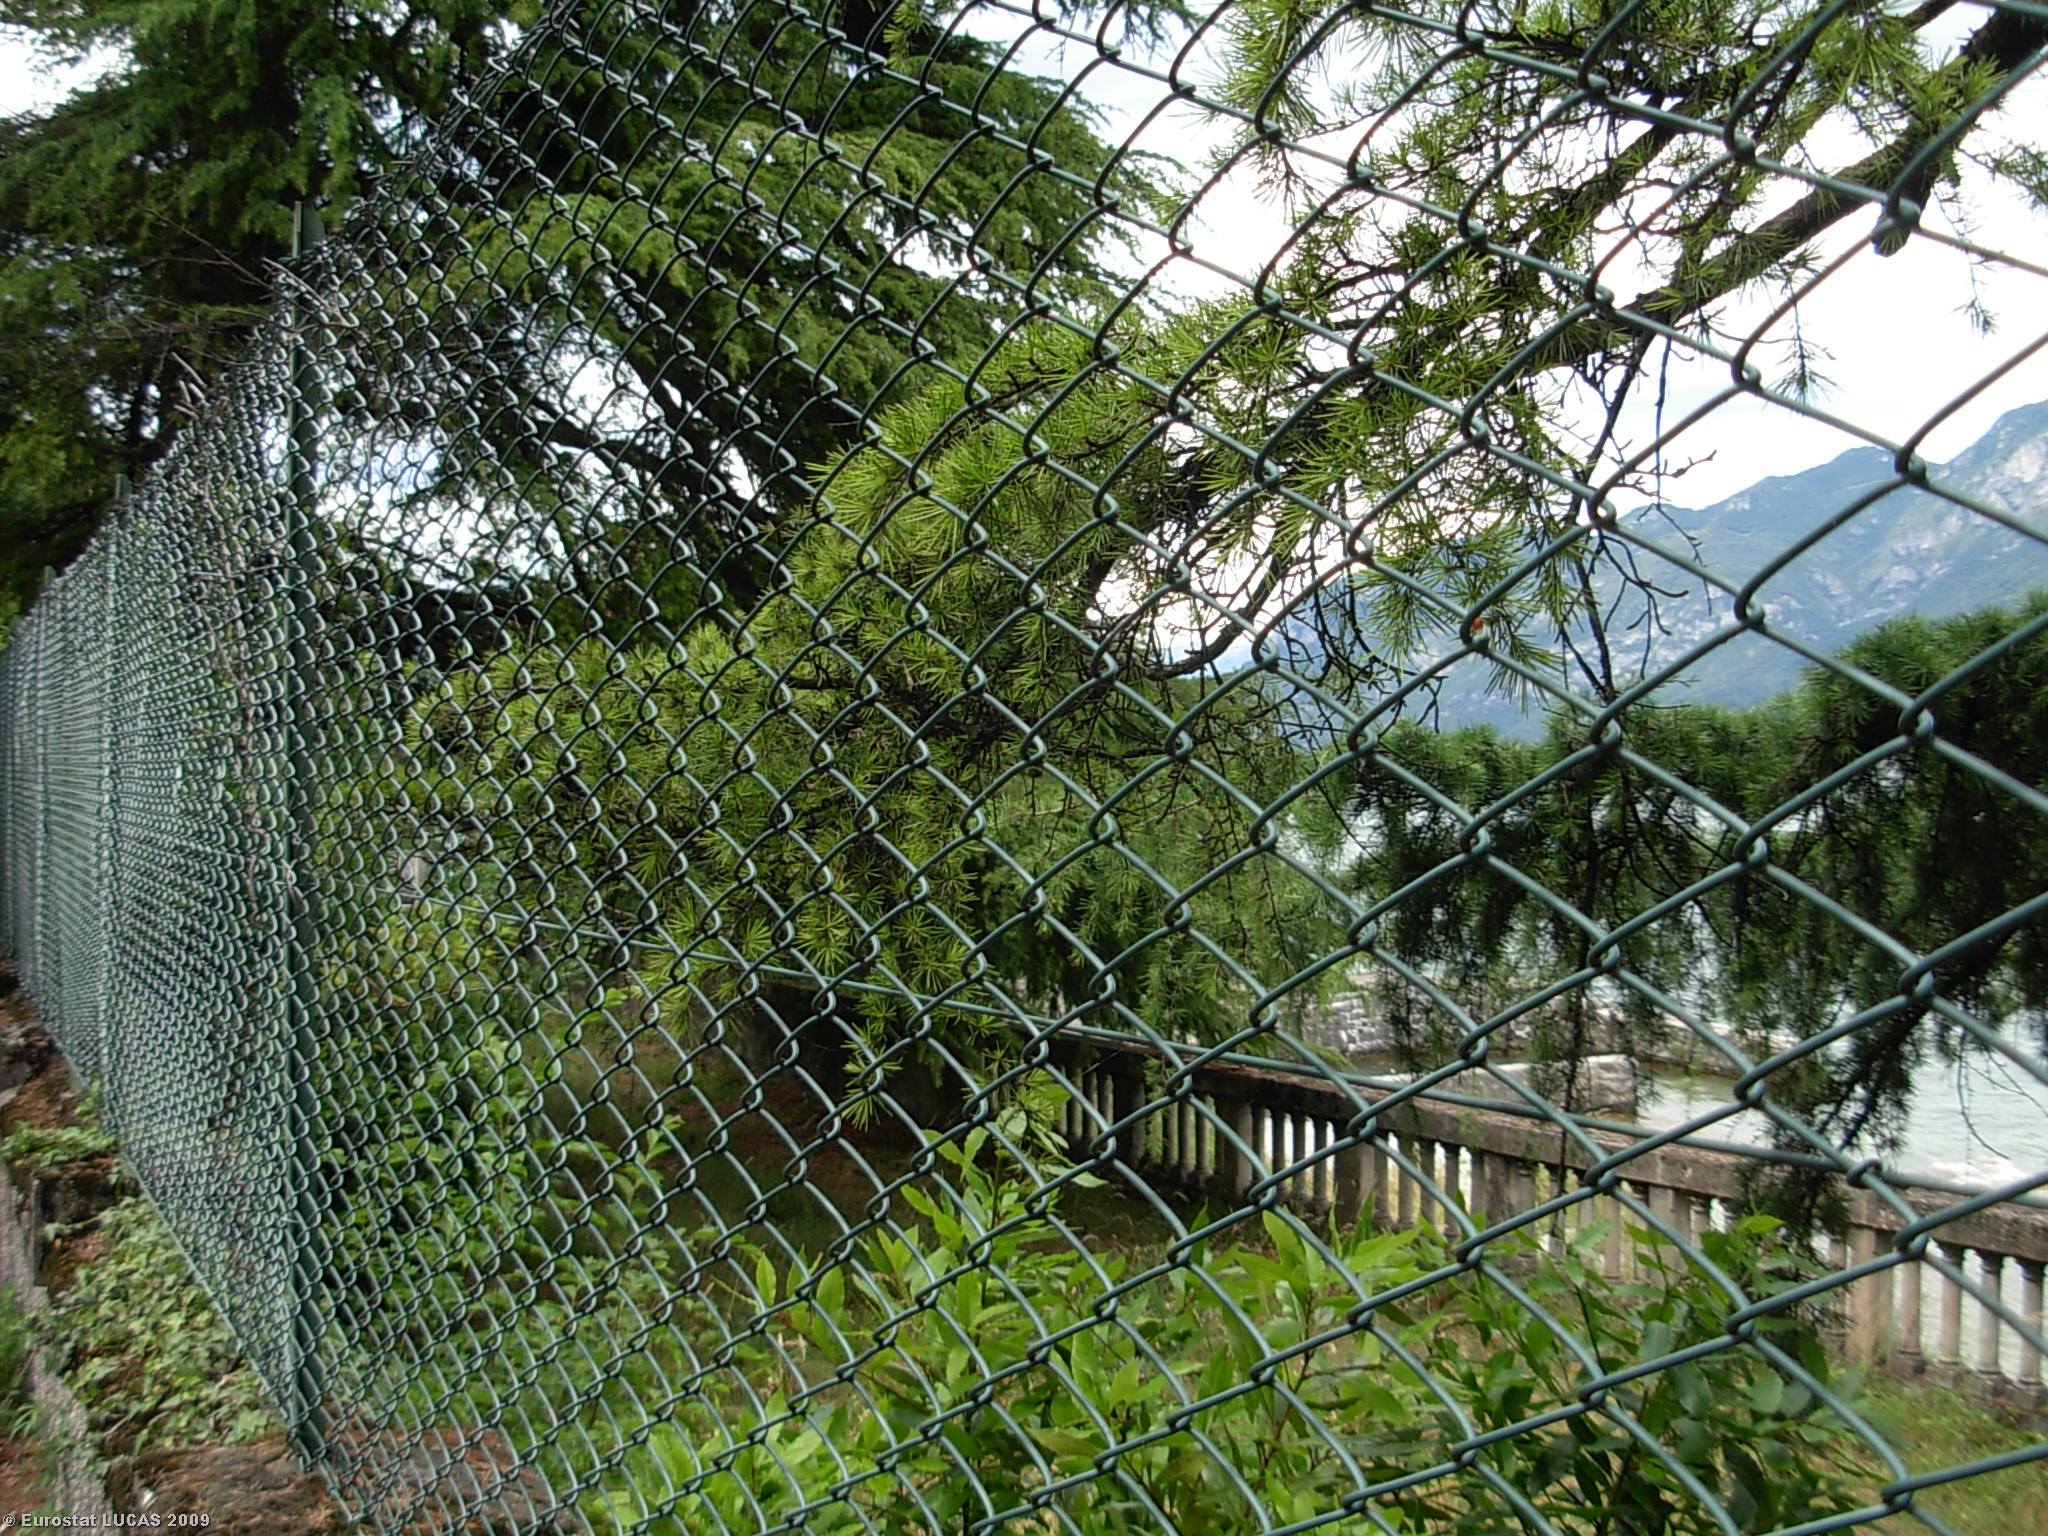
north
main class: Woodland
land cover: Coniferous woodland
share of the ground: > 75 %
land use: Holiday camps
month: June
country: IT
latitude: 45.9165
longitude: 9.2920
